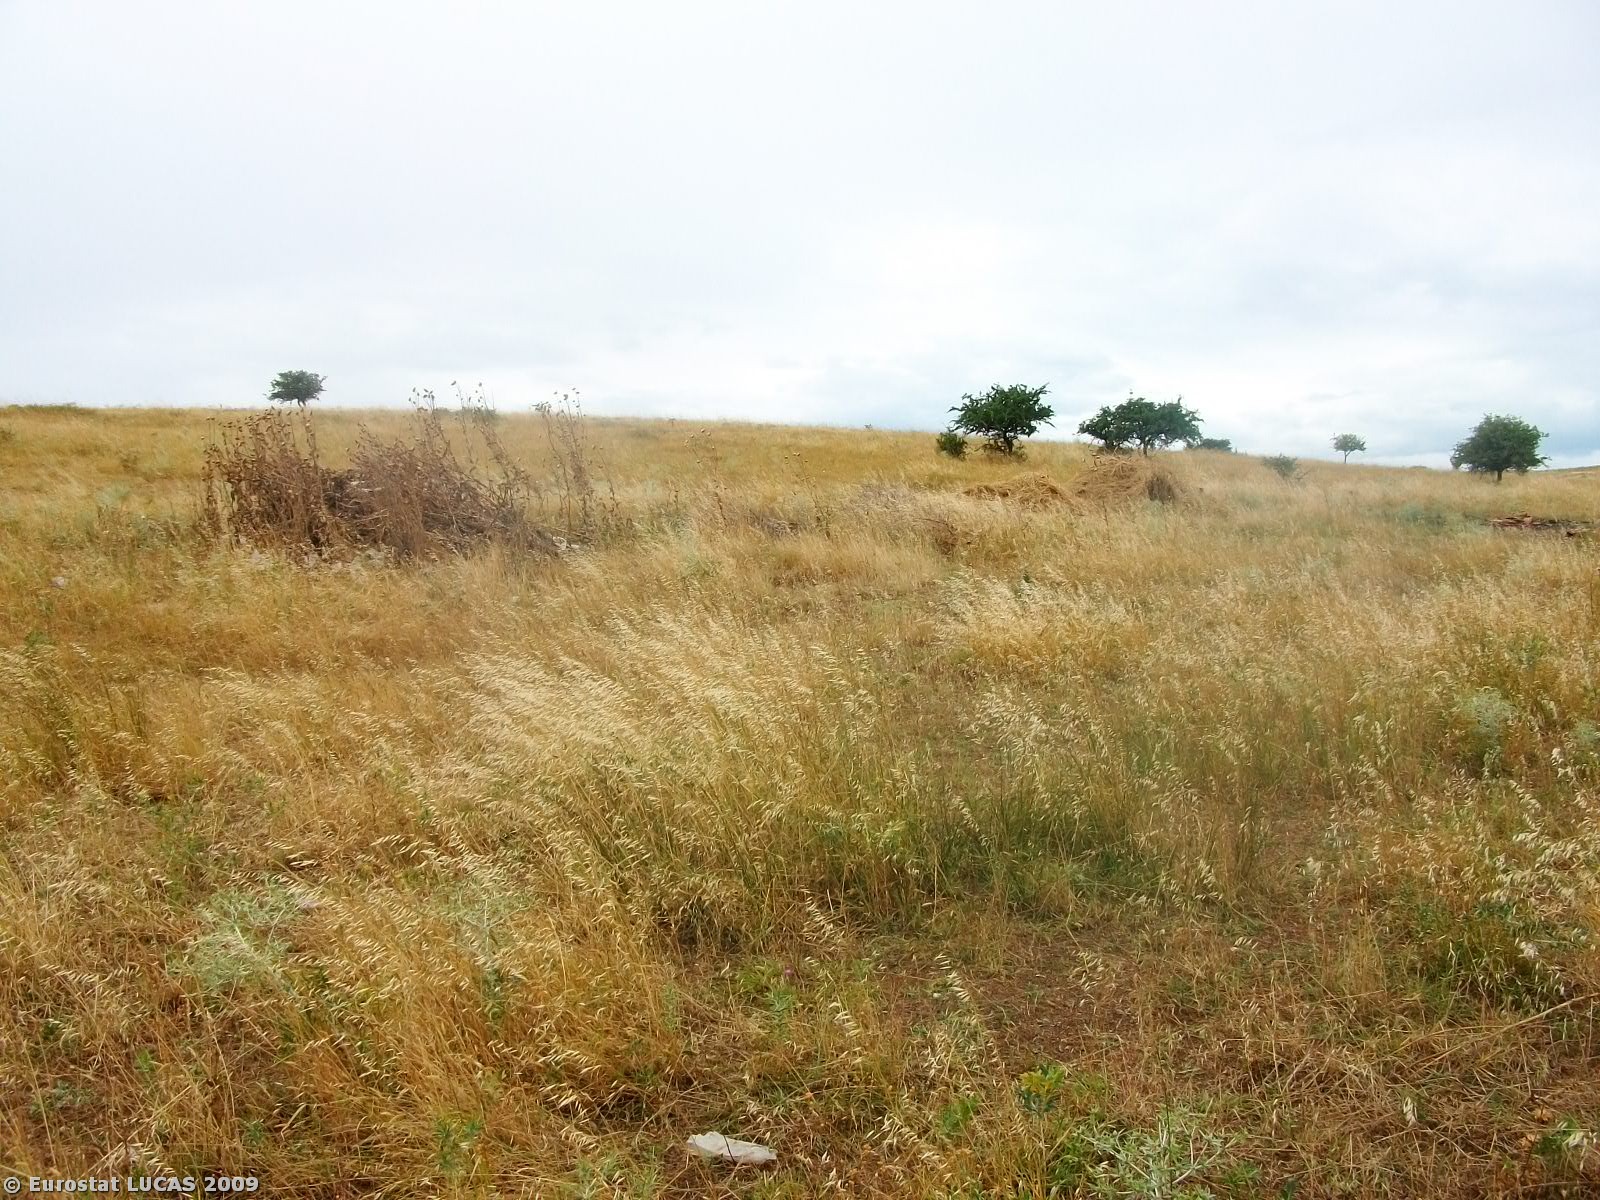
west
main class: Grassland
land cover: Grassland without tree/shrub cover
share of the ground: > 75 %
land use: Unused
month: June
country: GR
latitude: 41.0083
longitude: 22.7192
